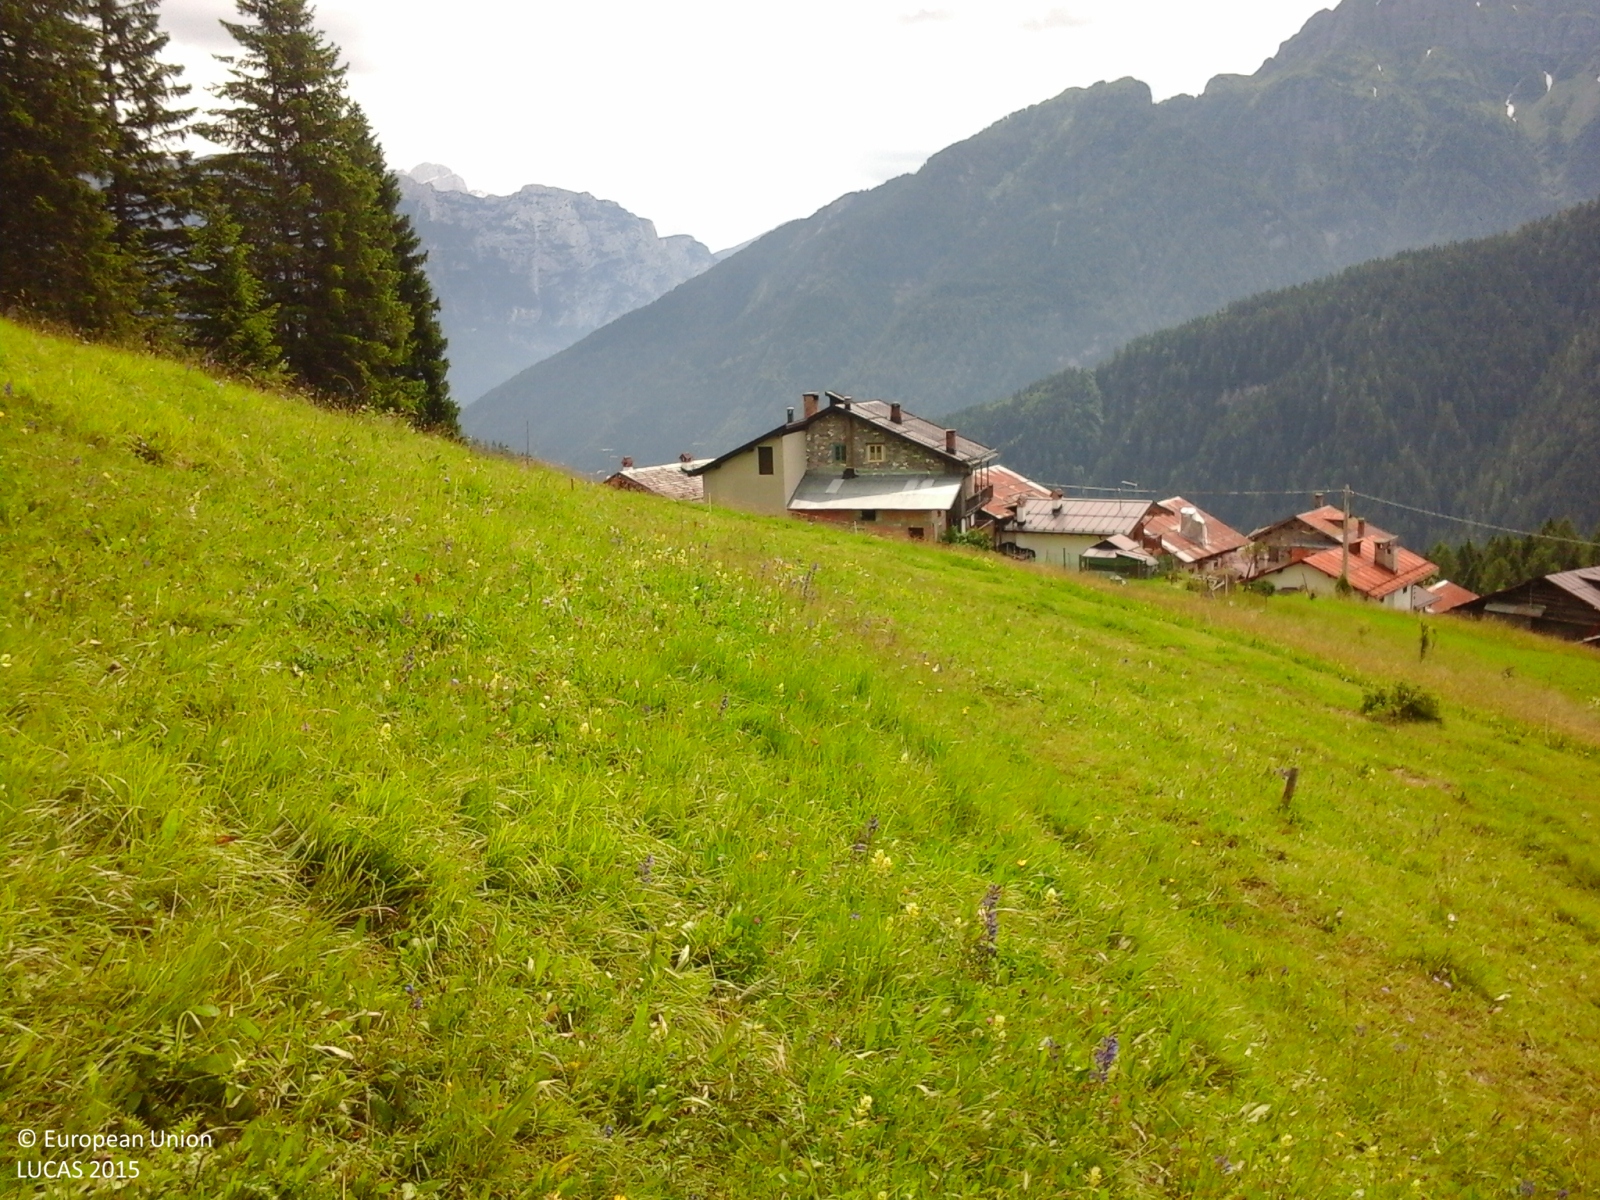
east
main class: Grassland
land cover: Grassland without tree/shrub cover
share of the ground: > 75 %
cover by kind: herbaceous plants 100 %
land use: Agriculture (excluding fallow land and kitchen gardens)
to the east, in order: Grassland without tree/shrub cover; Fences; Spruce dominated coniferous woodland; Grassland without tree/shrub cover; Tracks; Grassland without tree/shrub cover; Conifer hedges; Grassland without tree/shrub cover; Fences; Grassland without tree/shrub cover; Conifer hedges; Grassland without tree/shrub cover; Single bushes/trees; Grassland without tree/shrub cover; Broadleaved woodland
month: June
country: IT
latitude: 46.3707
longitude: 11.8826
